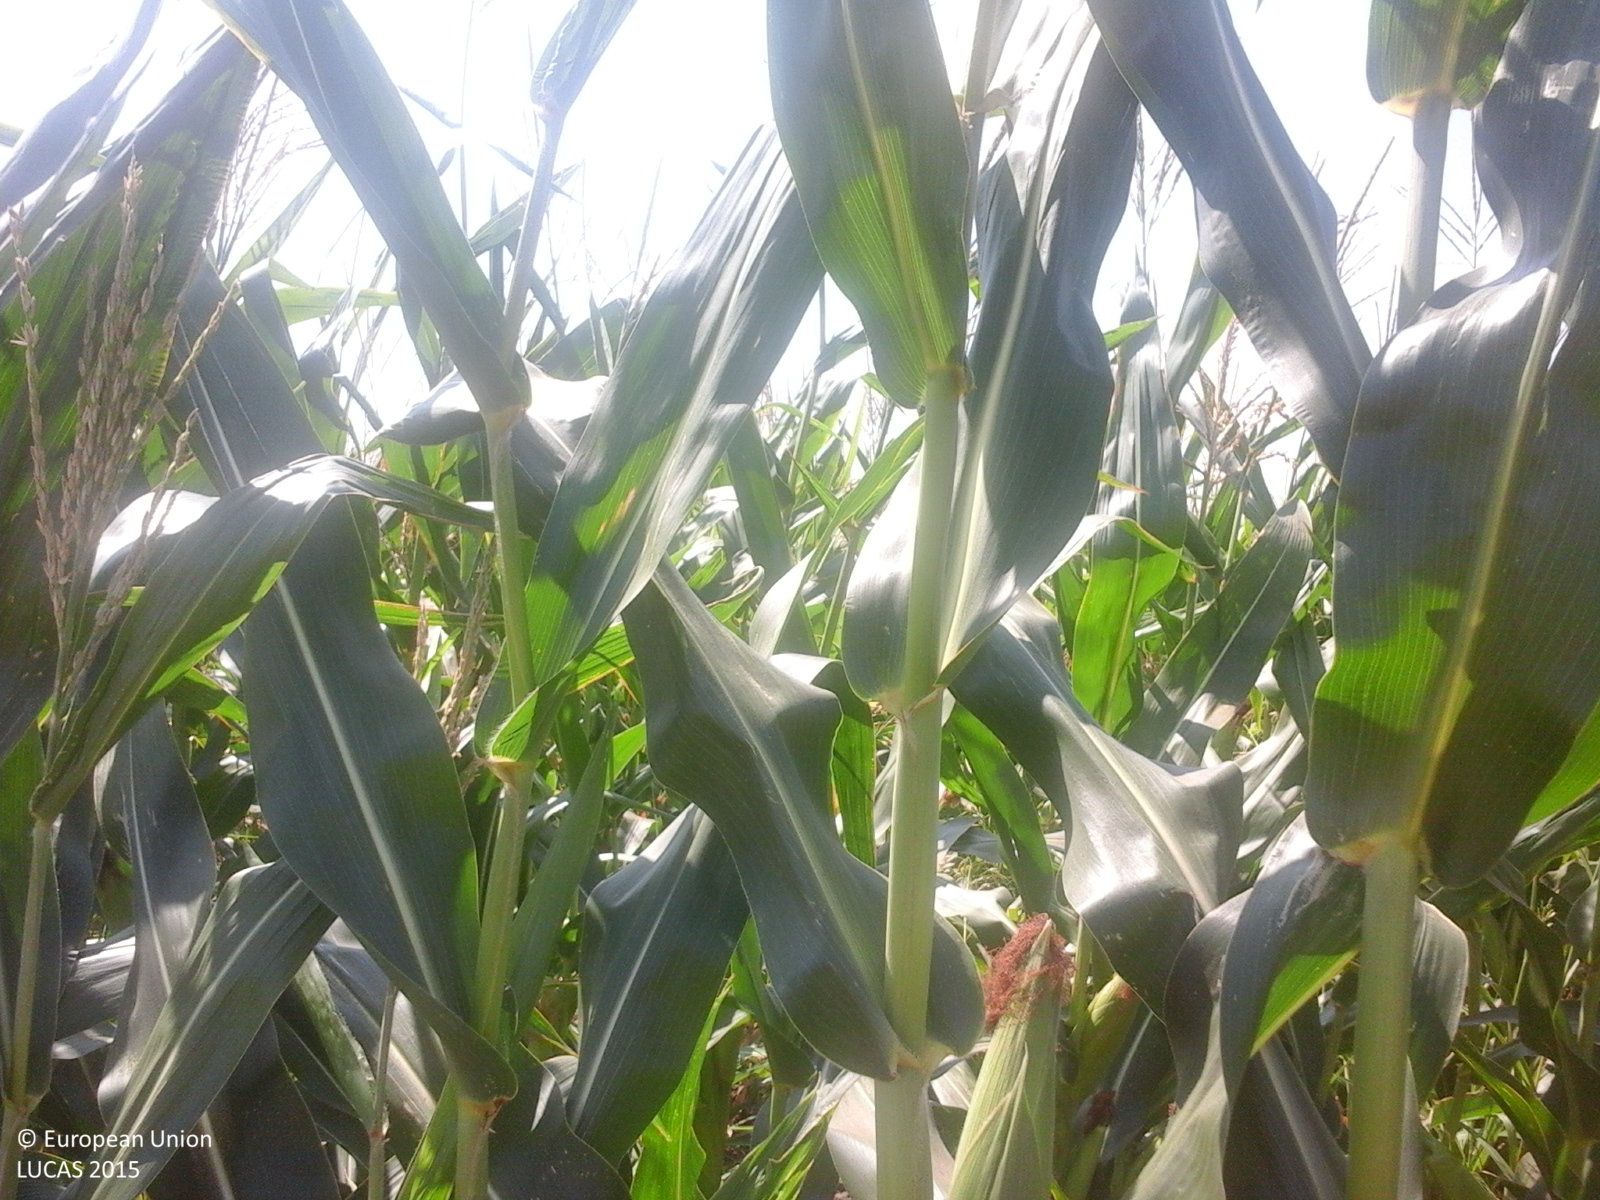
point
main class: Cropland
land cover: Maize
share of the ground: > 75 %
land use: Agriculture (excluding fallow land and kitchen gardens)
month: August
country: RO
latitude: 45.1423
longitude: 27.7716
